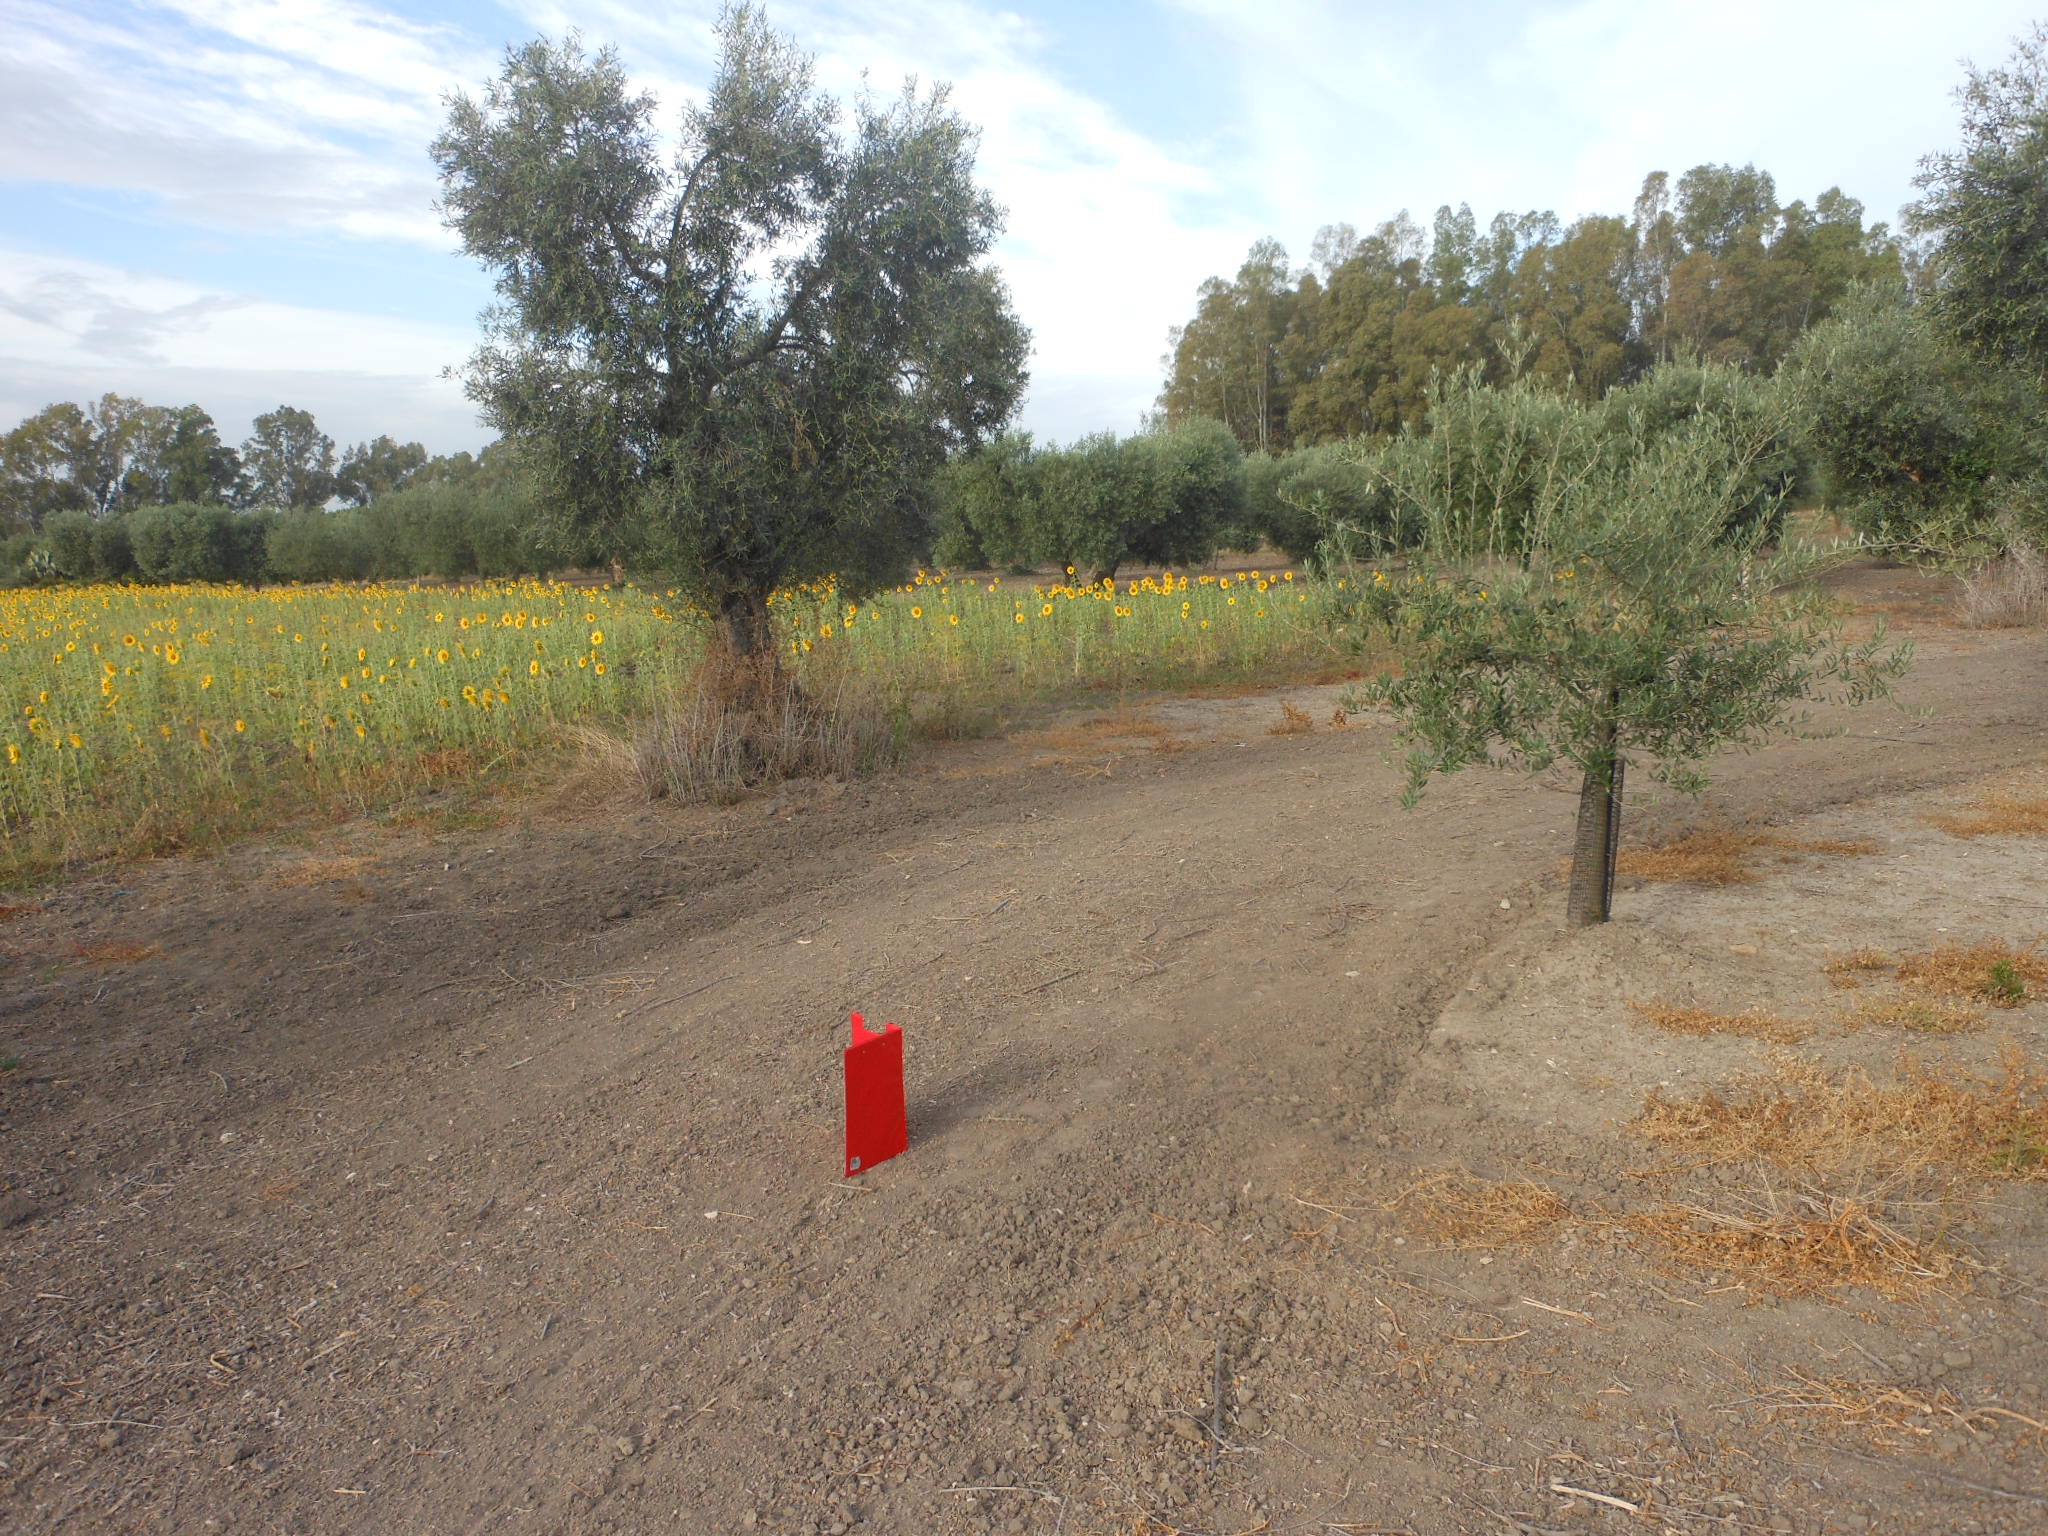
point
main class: Cropland
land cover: Olive groves
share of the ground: 50 - 75 %
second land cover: Other bare soil
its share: > 75 %
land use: Agriculture (excluding fallow land and kitchen gardens)
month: June
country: ES
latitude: 37.2362
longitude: -5.5352
